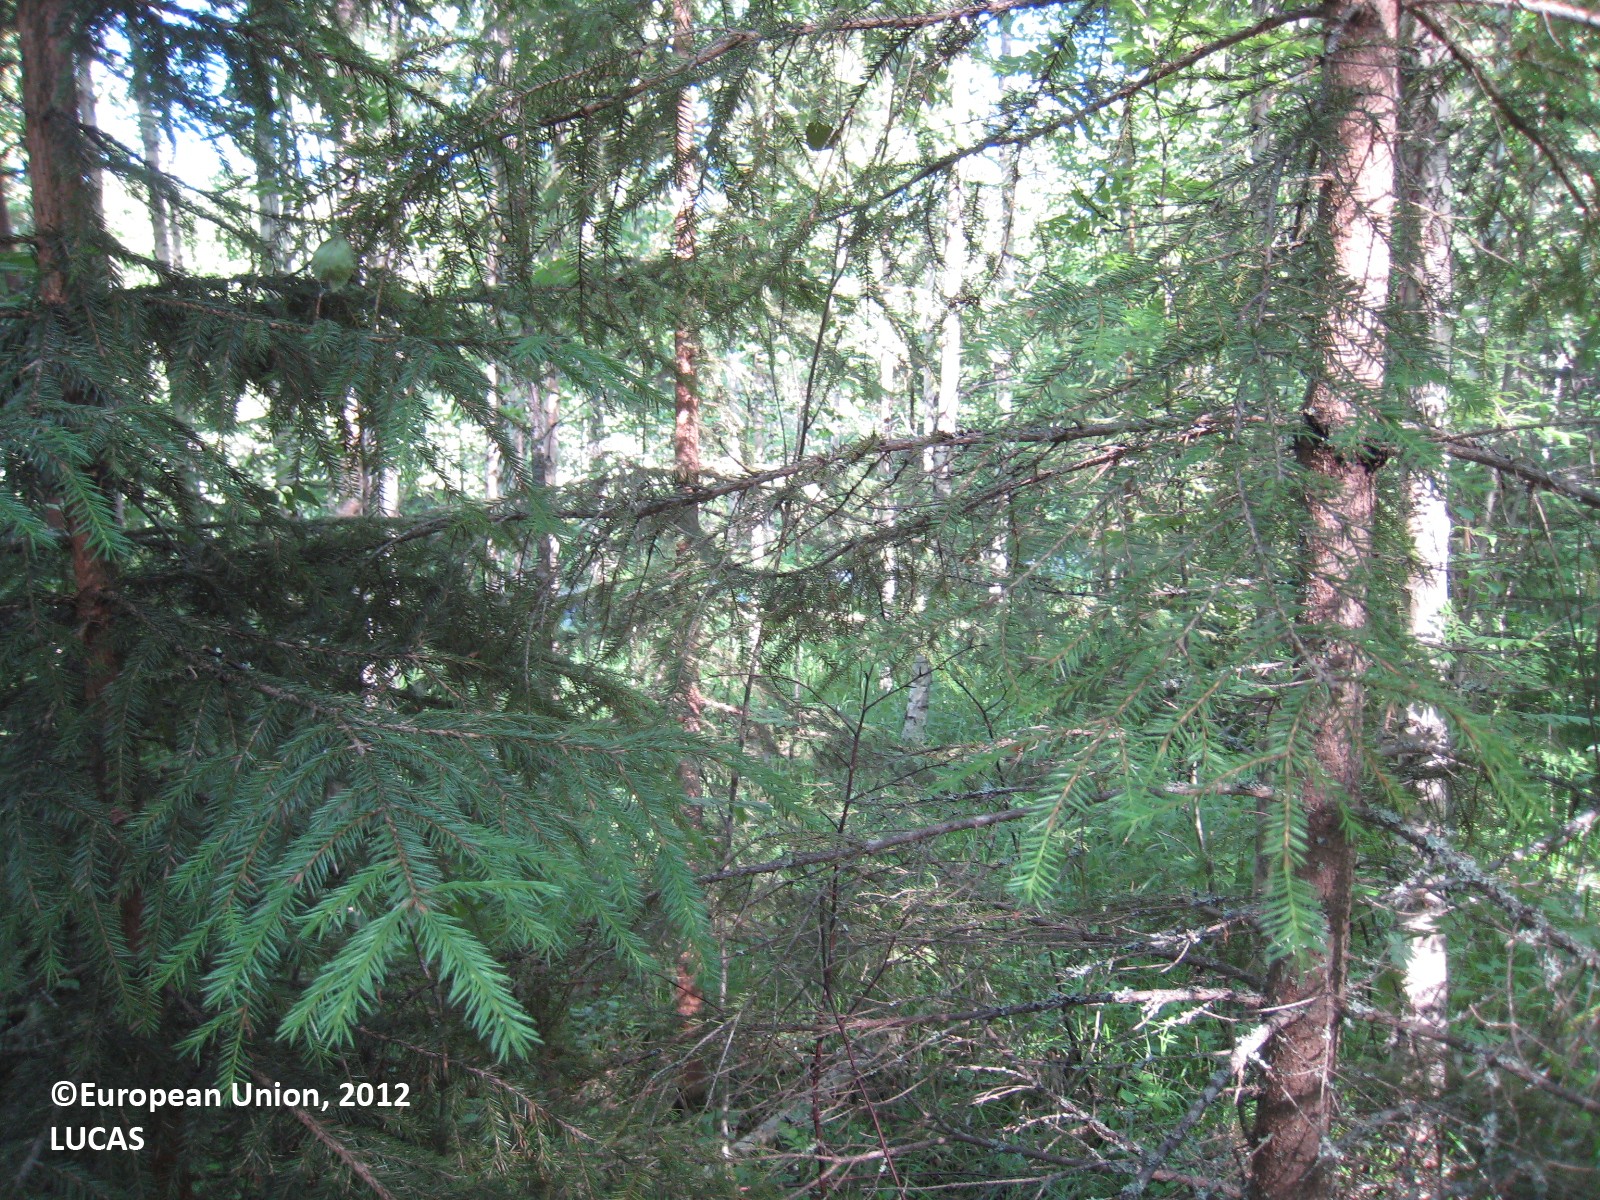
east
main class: Woodland
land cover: Spruce dominated mixed woodland
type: boreal forest
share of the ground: > 75 %
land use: Forestry
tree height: > 5 m
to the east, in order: Spruce dominated mixed woodland; Ditches and canals; Tracks; Spruce dominated mixed woodland; Ditches and canals; Spontaneously vegetated surfaces; Ditches and canals; Spontaneously vegetated surfaces; Ditches and canals; Spontaneously vegetated surfaces; Abandoned hedges; Ditches and canals; Temporary grasslands; Ditches and canals; Temporary grasslands; Ditches and canals; Temporary grasslands; Ditches and canals; Temporary grasslands; Ditches and canals; Spontaneously vegetated surfaces; Ditches and canals; Other mixed woodland; Spruce dominated mixed woodland
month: June
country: FI
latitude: 62.4575
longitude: 26.4391
